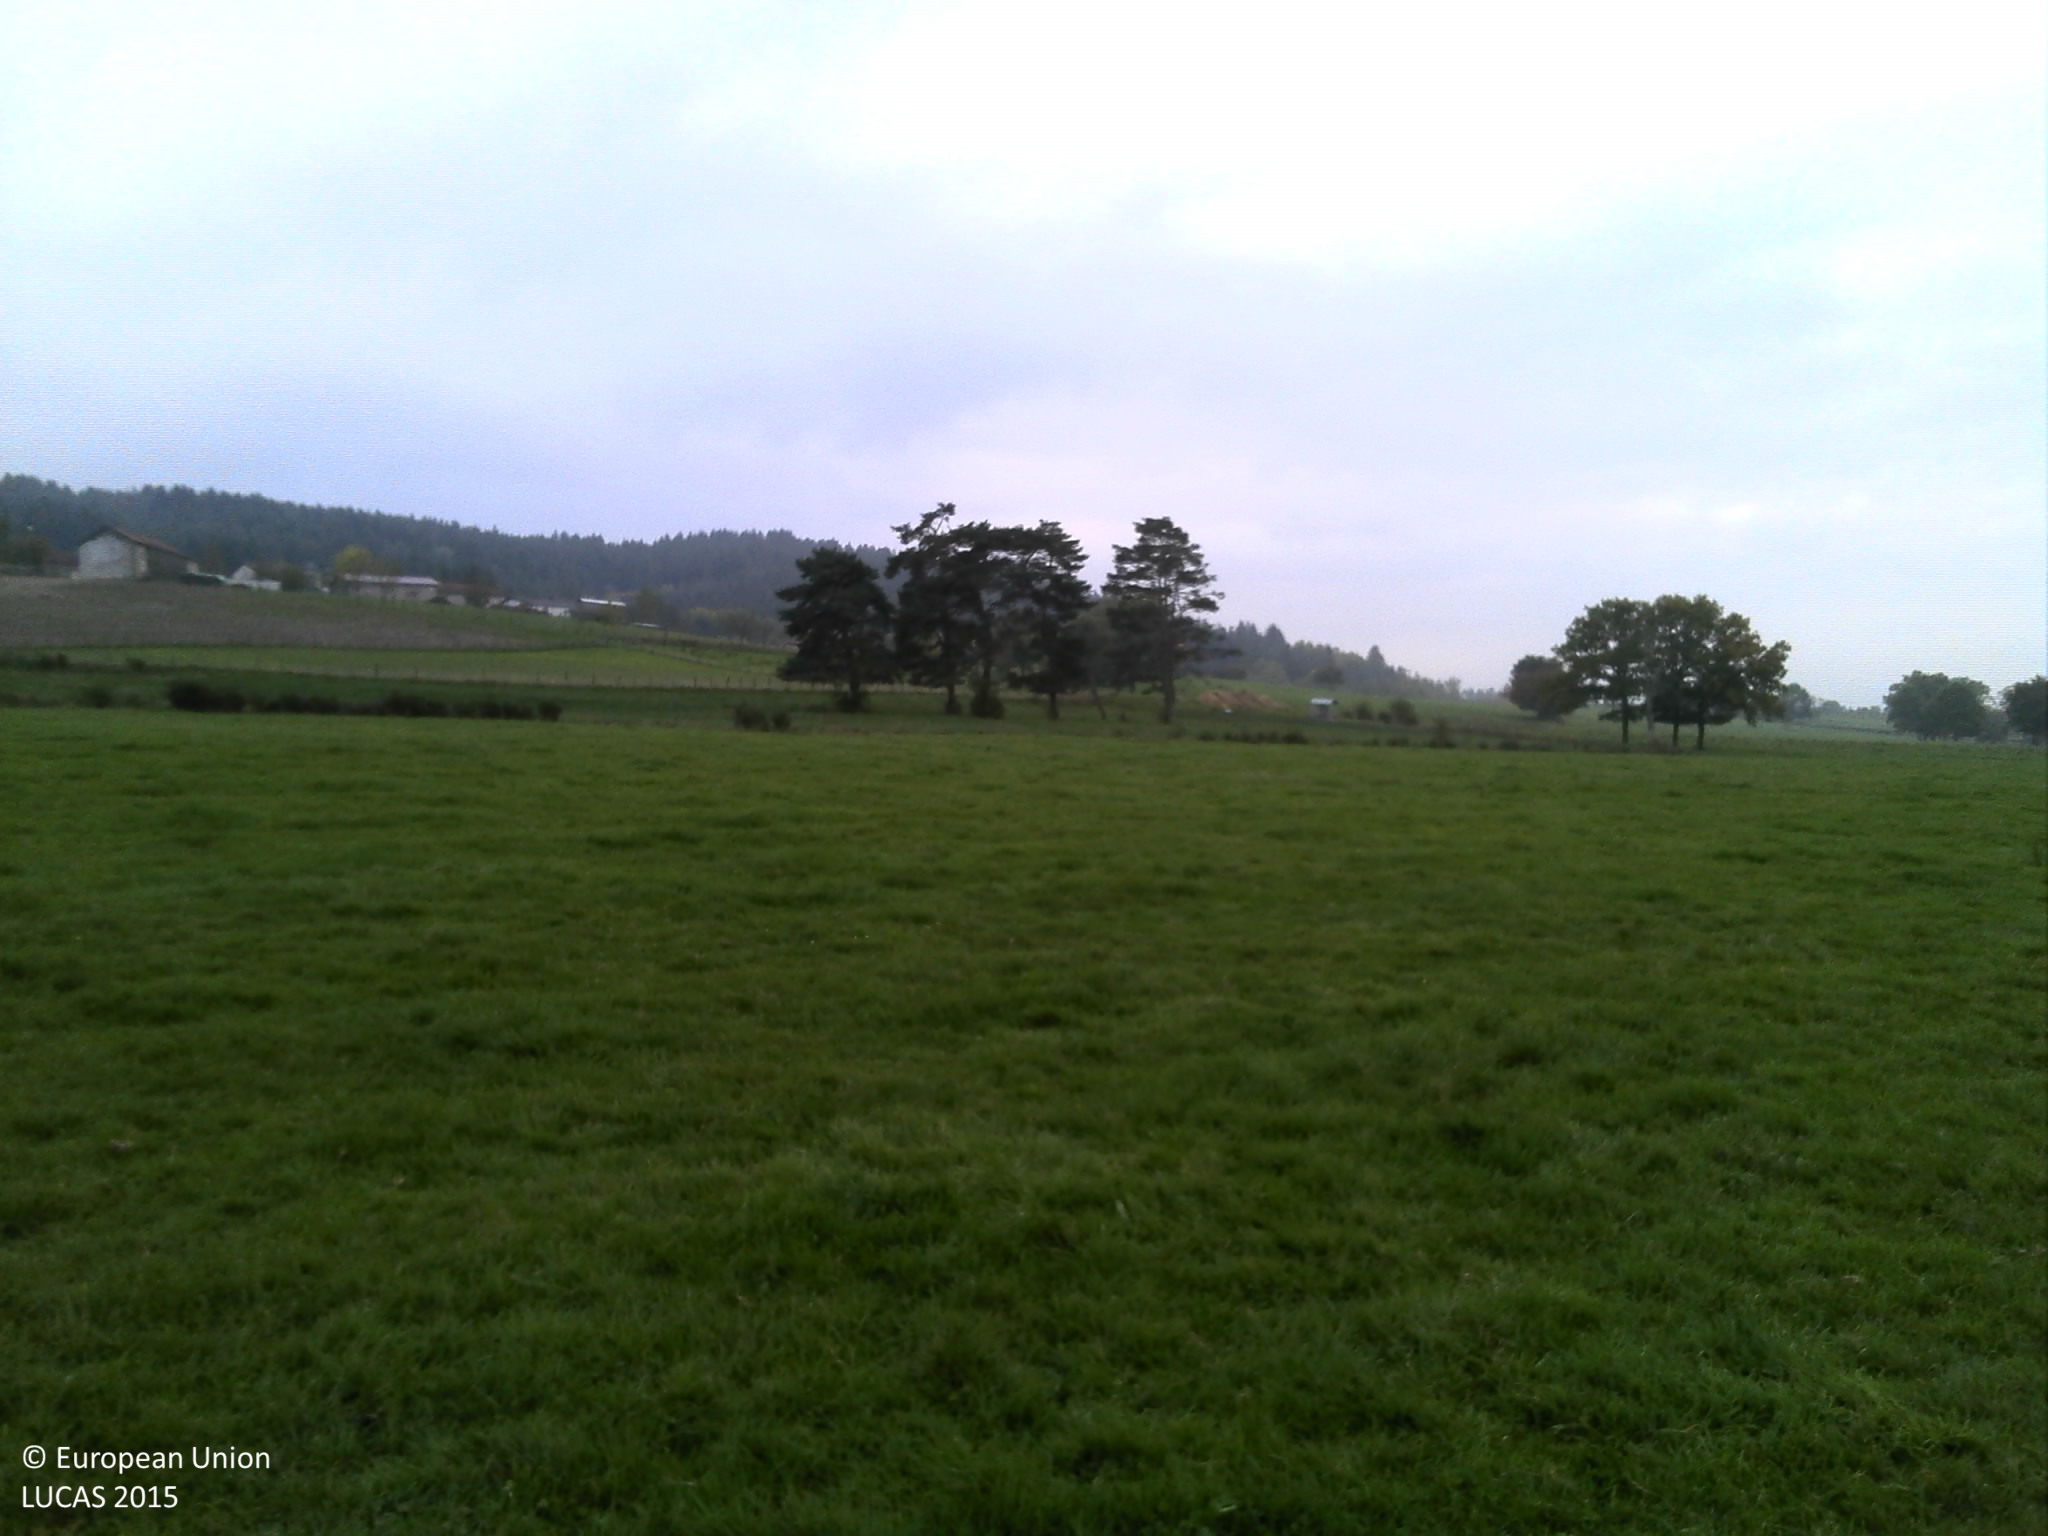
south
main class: Grassland
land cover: Grassland without tree/shrub cover
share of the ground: > 75 %
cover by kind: herbaceous plants 100 %
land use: Agriculture (excluding fallow land and kitchen gardens)
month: October
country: FR
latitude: 45.5370
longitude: 3.7658
